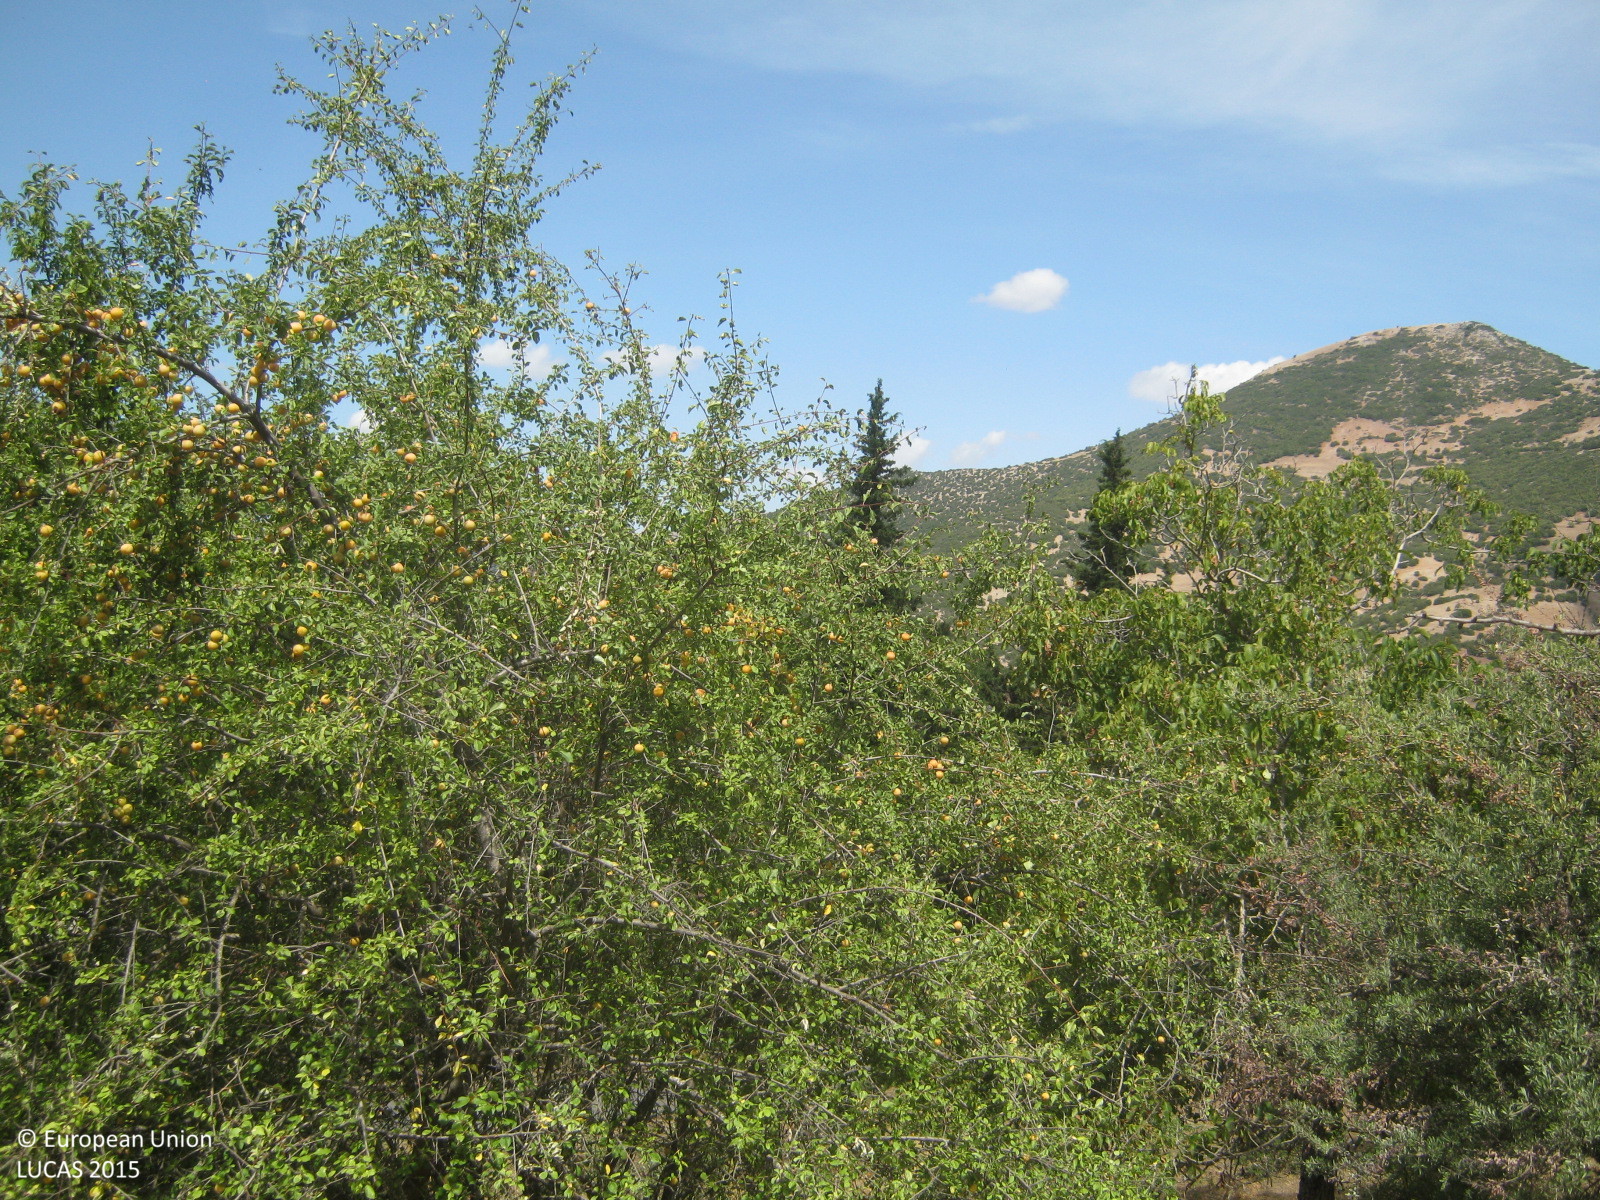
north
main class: Cropland
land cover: Other fruit trees and berries
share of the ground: 50 - 75 %
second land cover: Spontaneously vegetated surfaces
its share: 50 - 75 %
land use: Agriculture (excluding fallow land and kitchen gardens)
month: September
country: GR
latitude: 37.9415
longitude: 22.1072
